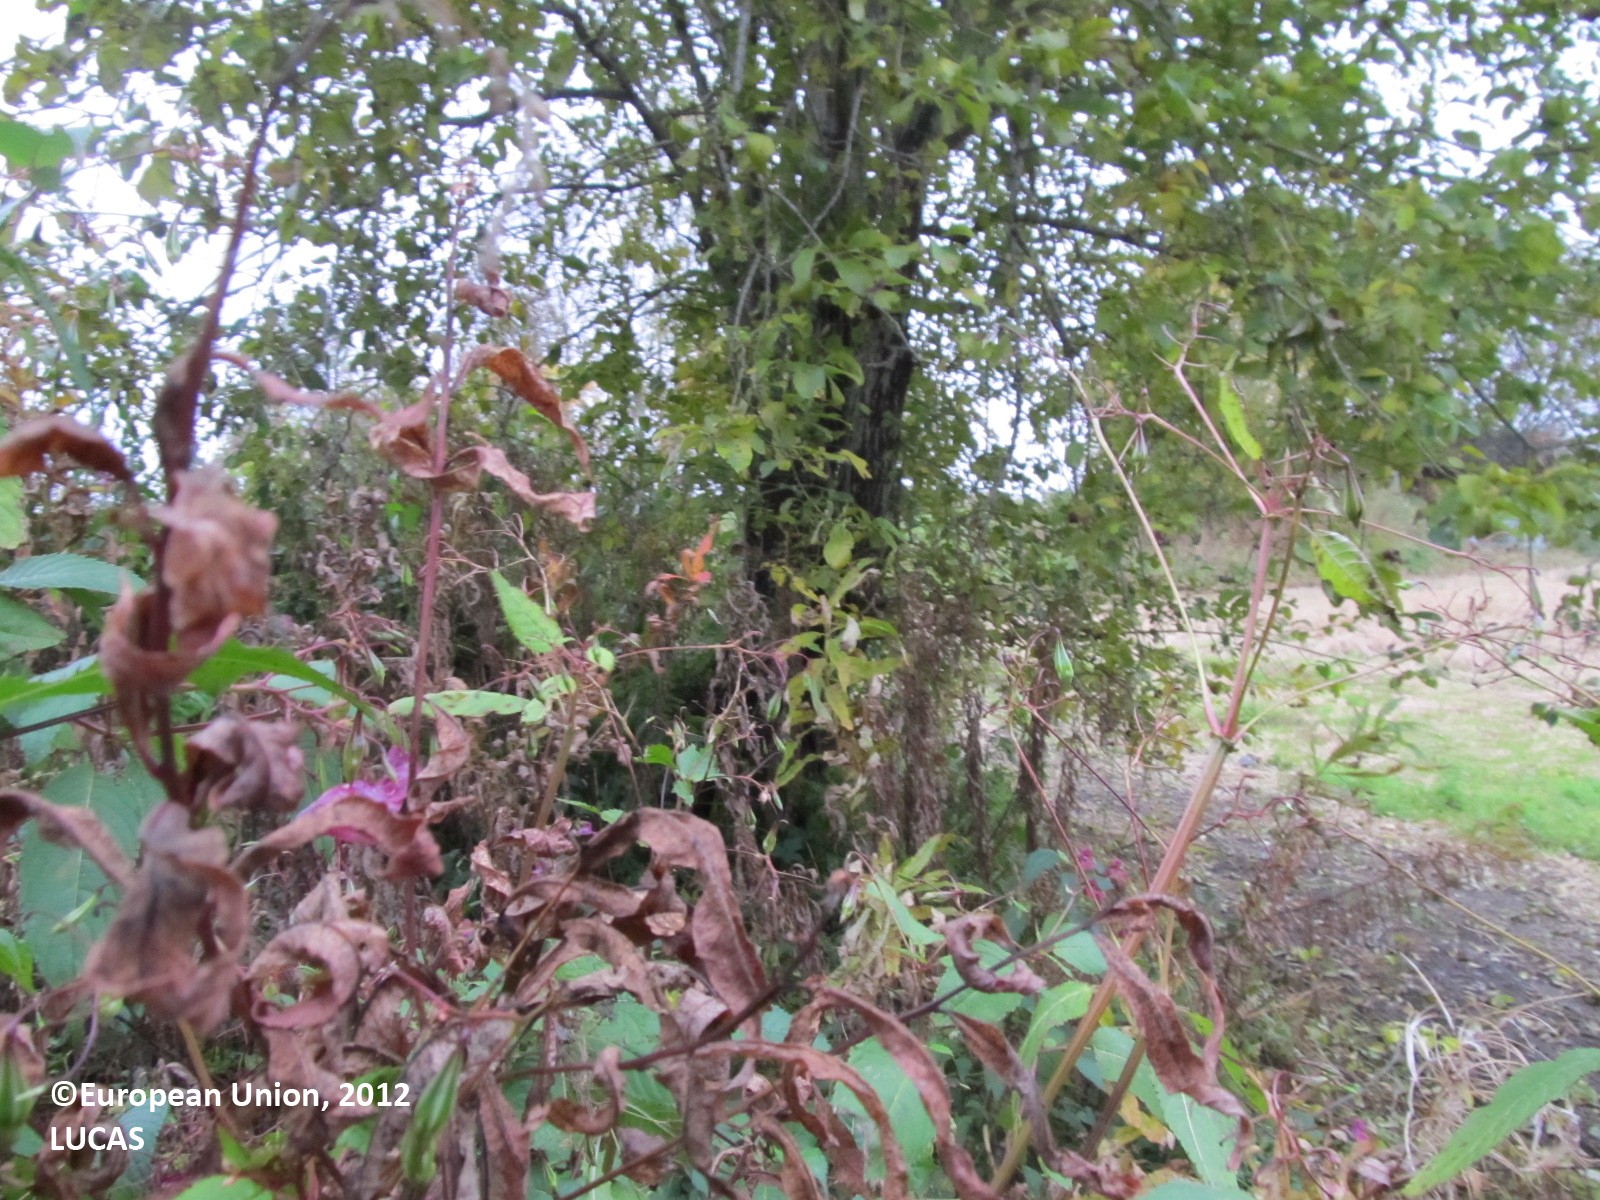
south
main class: Shrubland
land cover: Shrubland with sparse tree cover
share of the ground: > 75 %
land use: Semi-natural and natural areas not in use
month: September
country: FI
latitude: 62.2600
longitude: 28.1197
